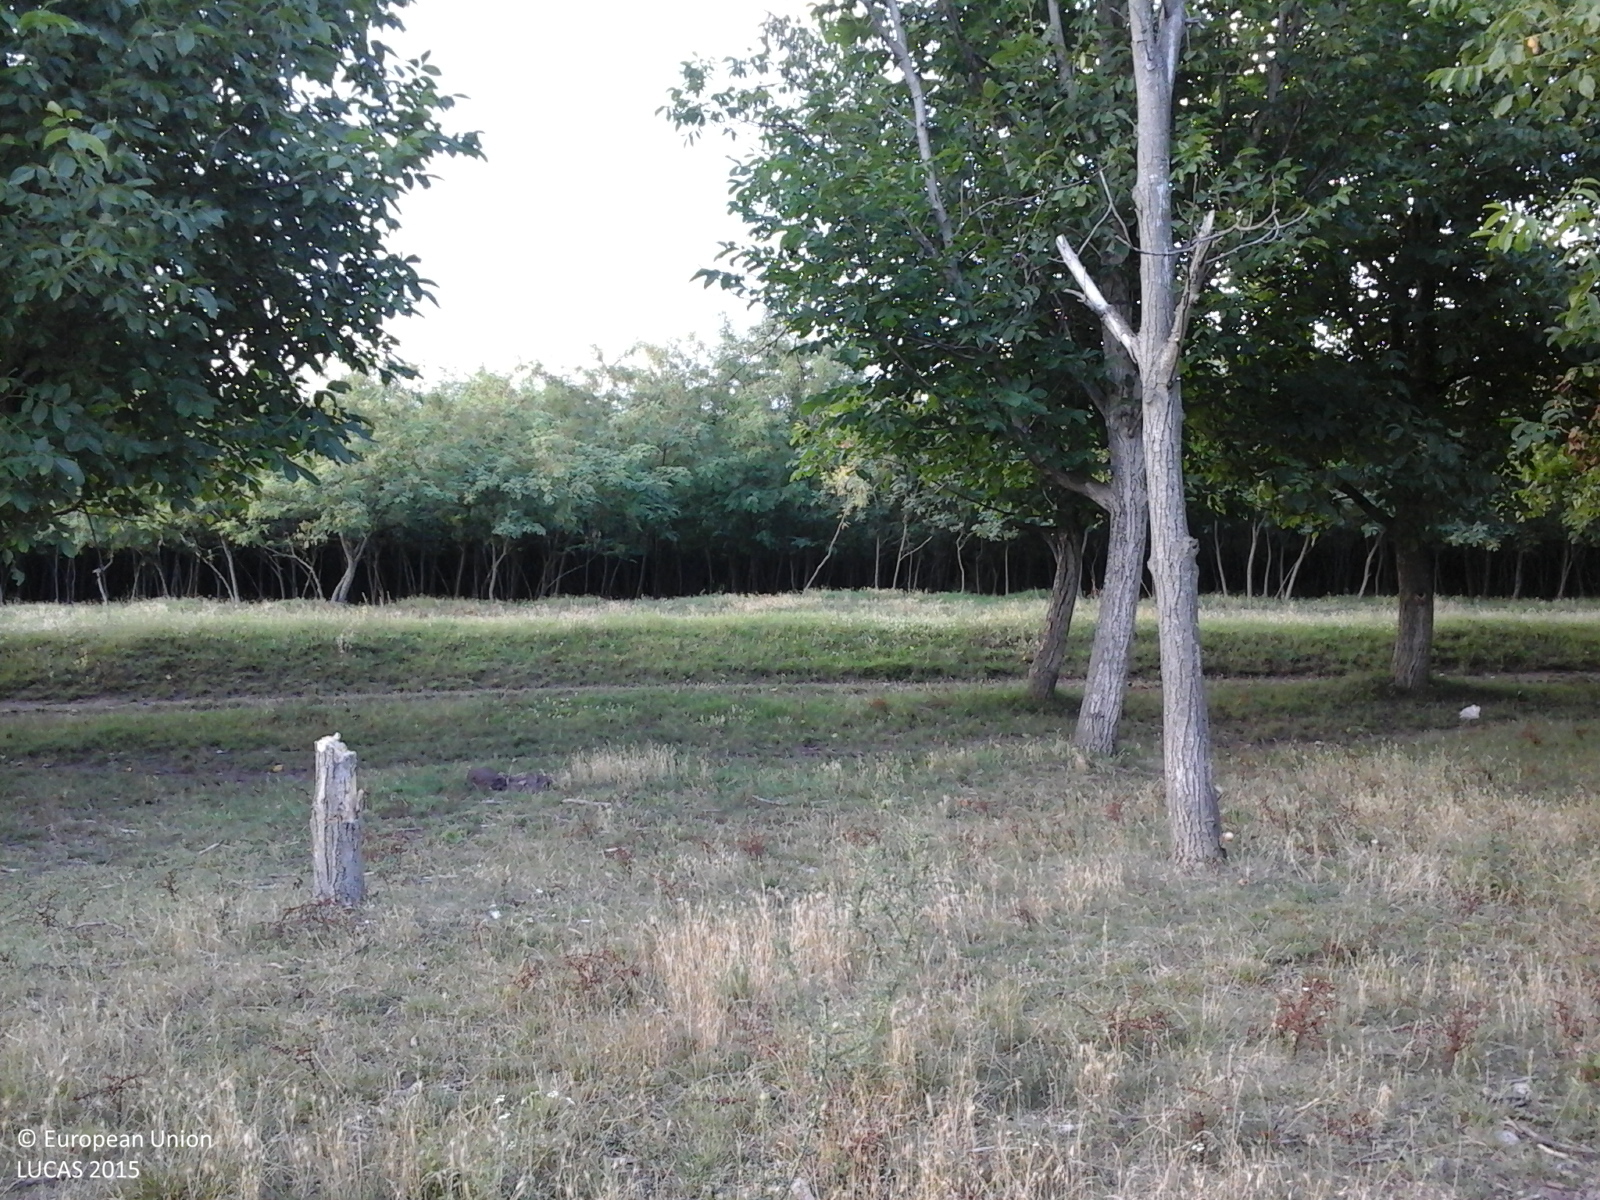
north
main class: Cropland
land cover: Nuts trees
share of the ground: 50 - 75 %
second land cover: Grassland without tree/shrub cover
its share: > 75 %
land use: Agriculture (excluding fallow land and kitchen gardens)
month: July
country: RO
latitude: 43.9432
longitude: 24.4045
